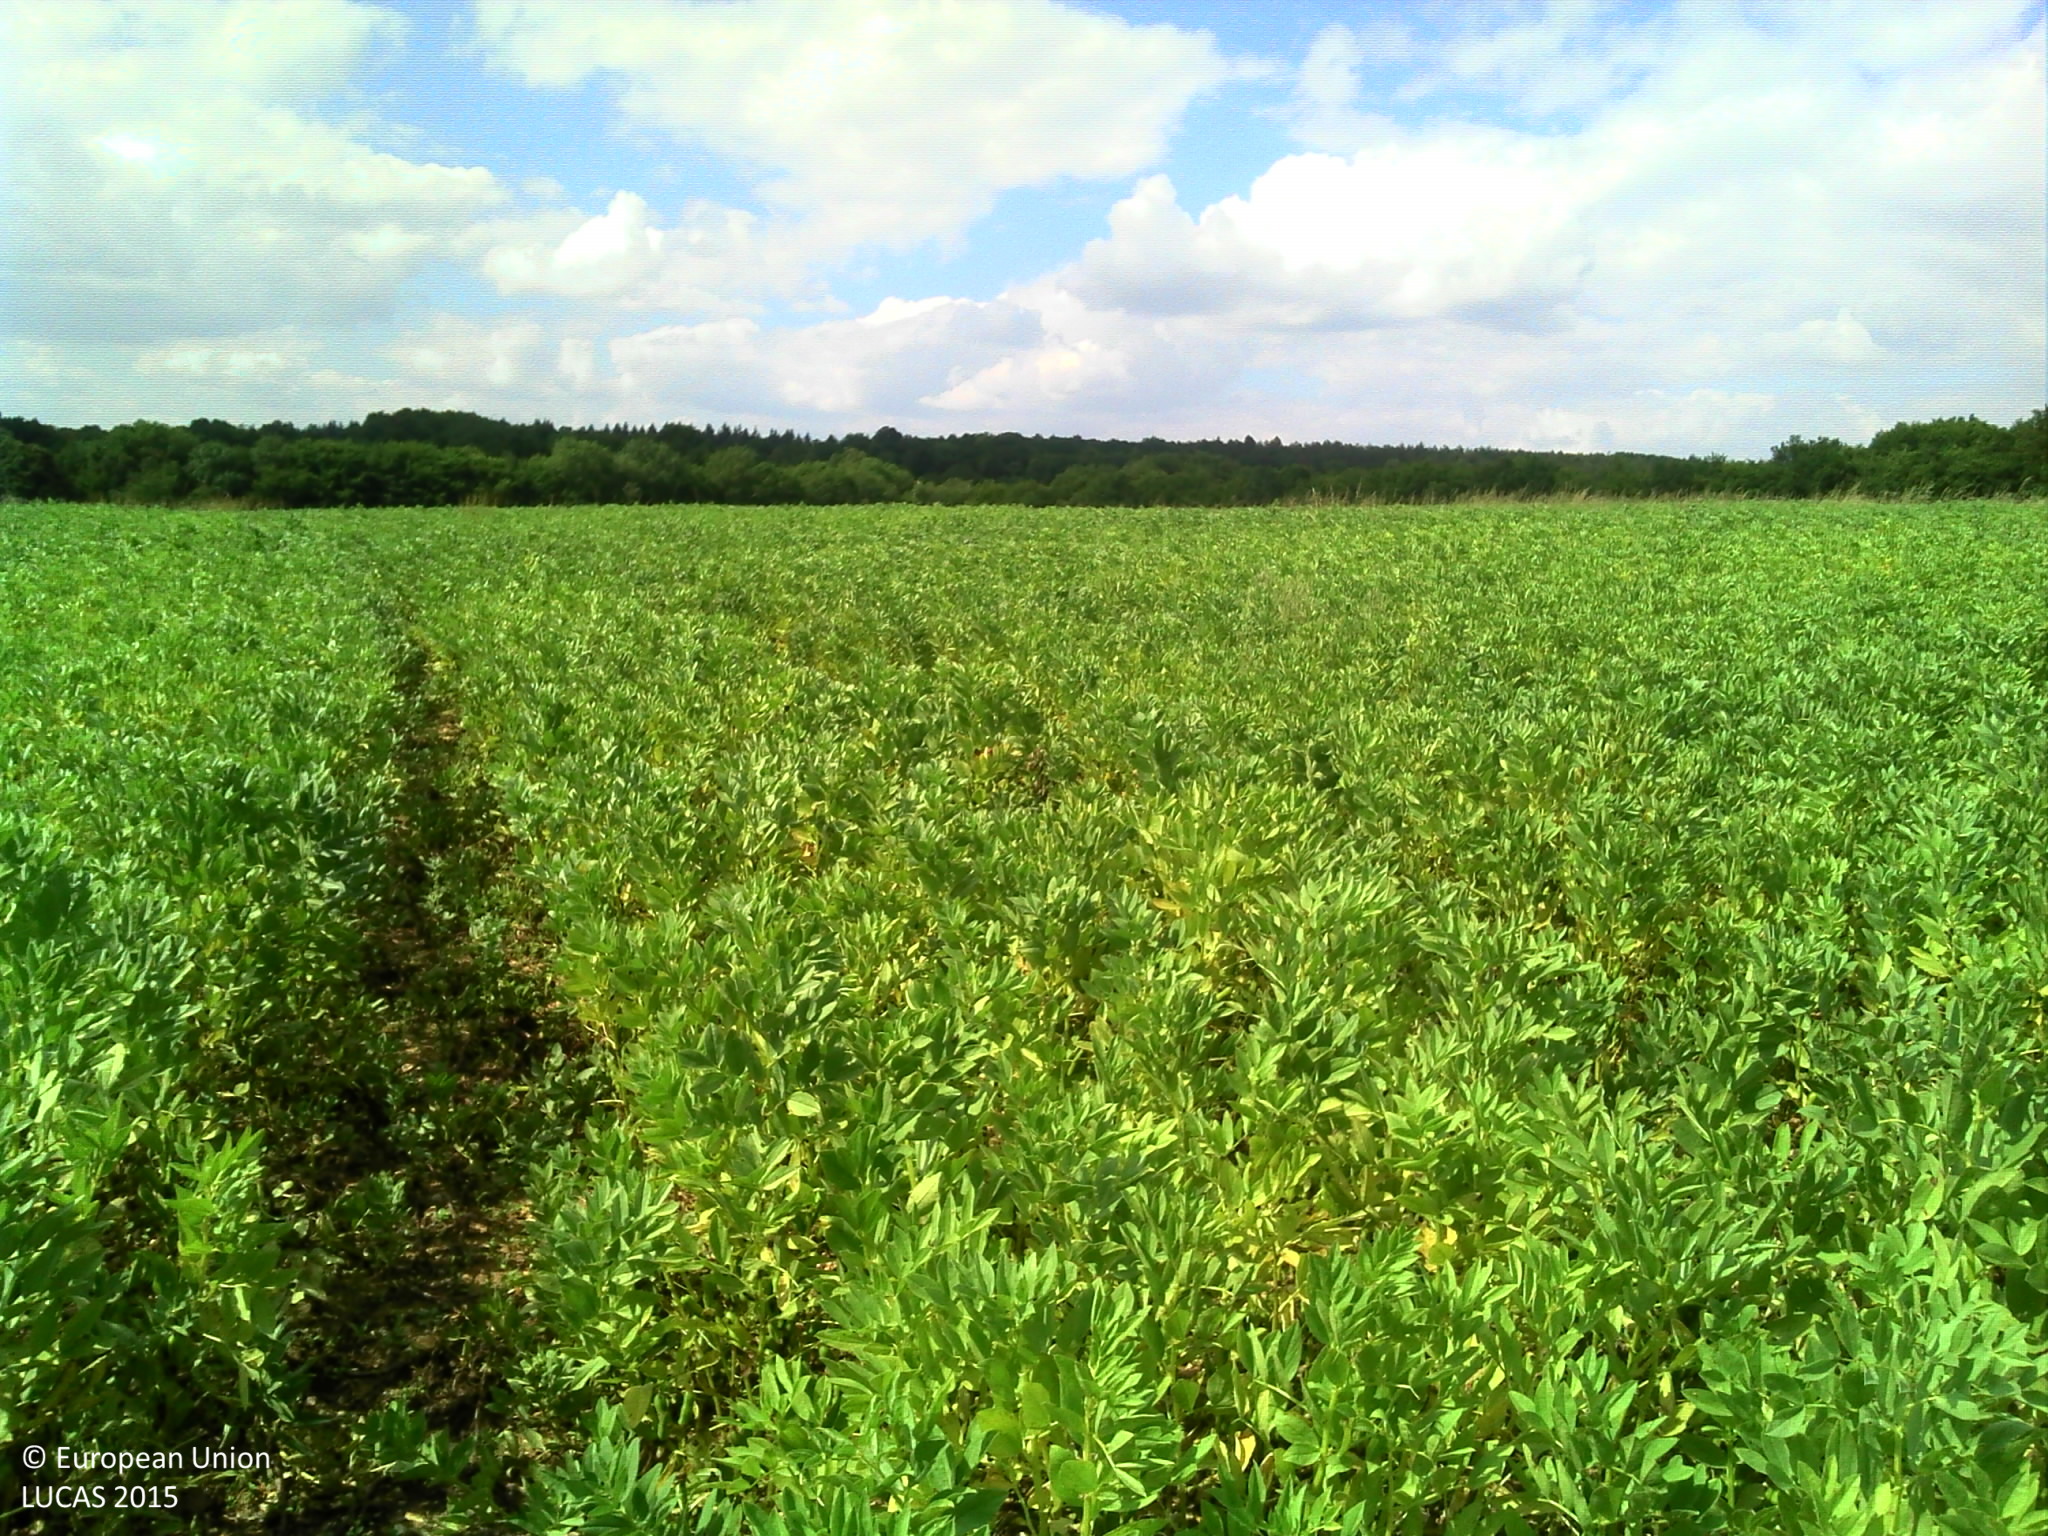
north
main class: Cropland
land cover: Dry pulses
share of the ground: > 75 %
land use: Agriculture (excluding fallow land and kitchen gardens)
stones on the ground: 10 - 25 %
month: June
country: FR
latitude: 47.3937
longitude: 2.5601
